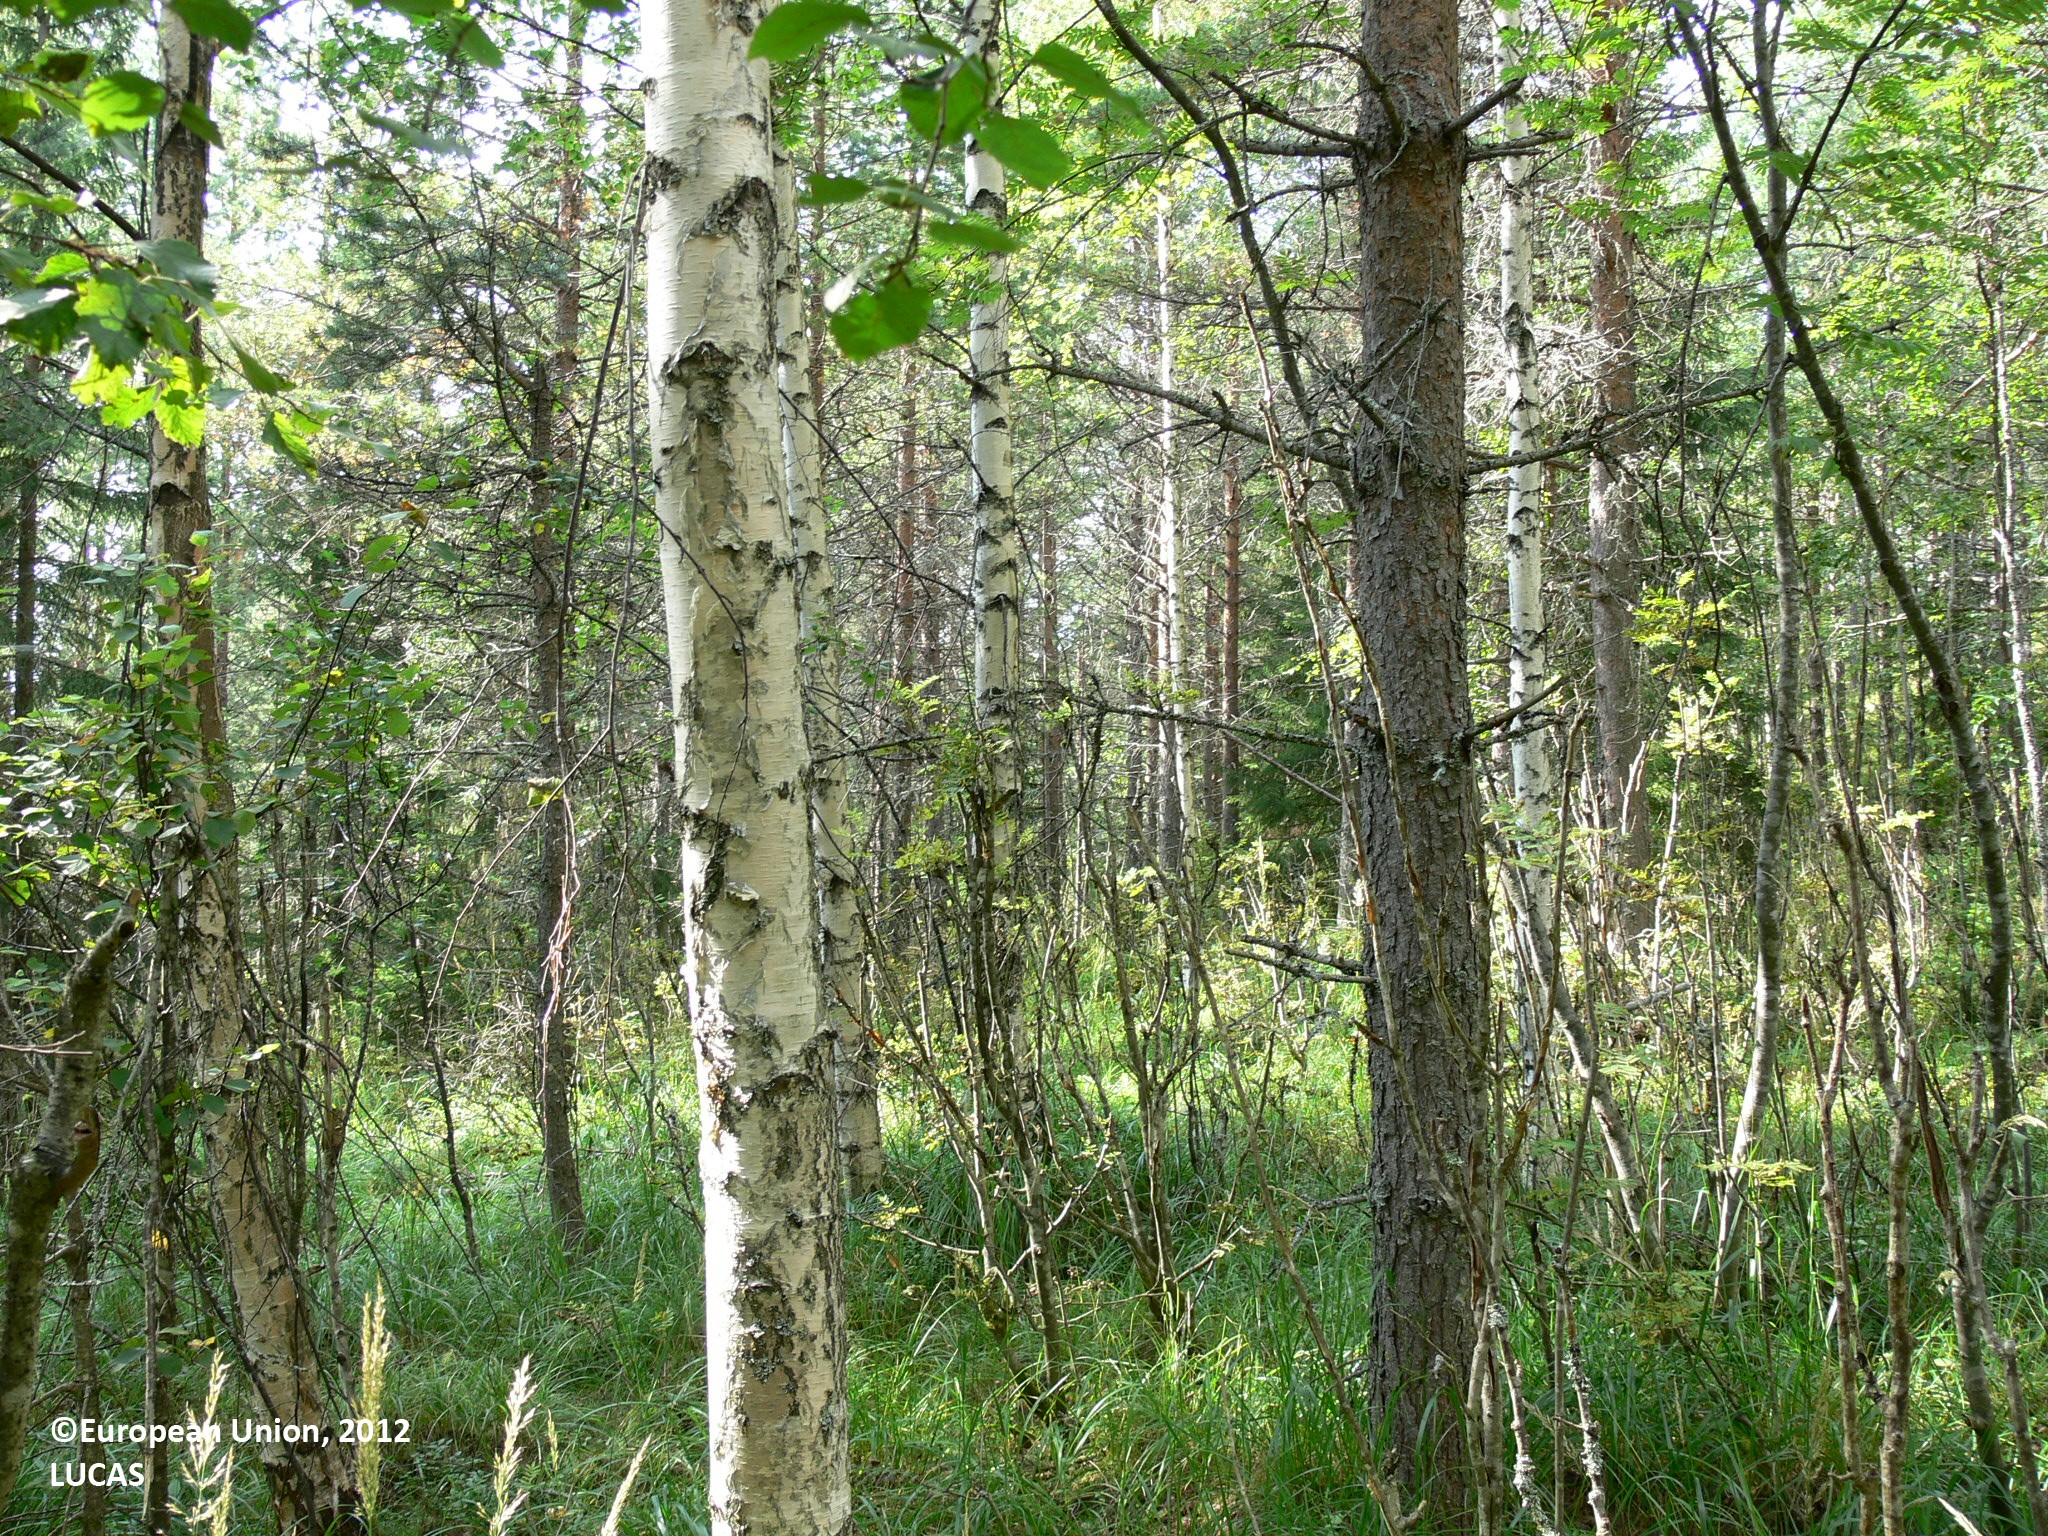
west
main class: Woodland
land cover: Other mixed woodland
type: boreal forest
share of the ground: > 75 %
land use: Amenities, museums, leisure
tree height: > 5 m
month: August
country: FI
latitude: 63.0149
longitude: 29.9463
